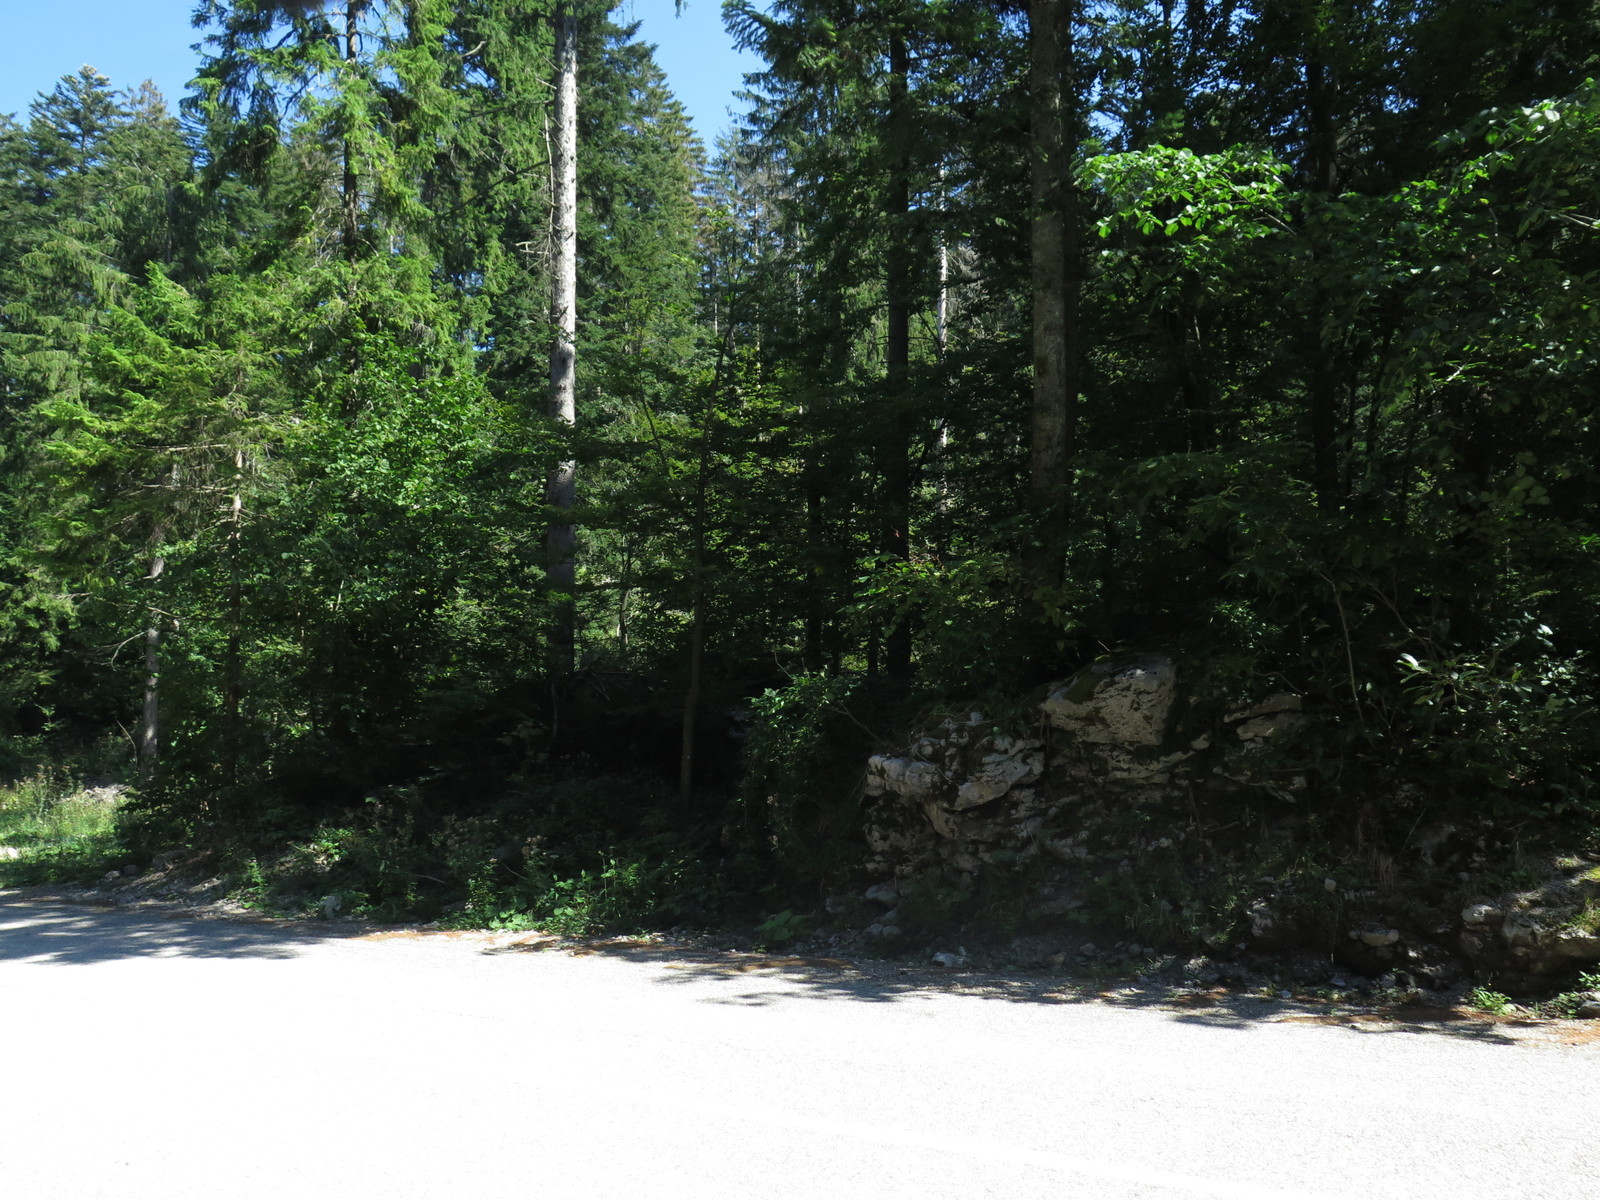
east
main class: Woodland
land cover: Other mixed woodland
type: mountainous beech forest
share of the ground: > 75 %
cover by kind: coniferous forest trees 75 %, broadleaved forest trees 25 %
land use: Forestry
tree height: > 5 m
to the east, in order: Other mixed woodland; Grass margins; Paved roads, cycling and walking lanes; Sand; Rocks and stones; Other mixed woodland
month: August
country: HR
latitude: 45.3431
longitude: 14.7554
